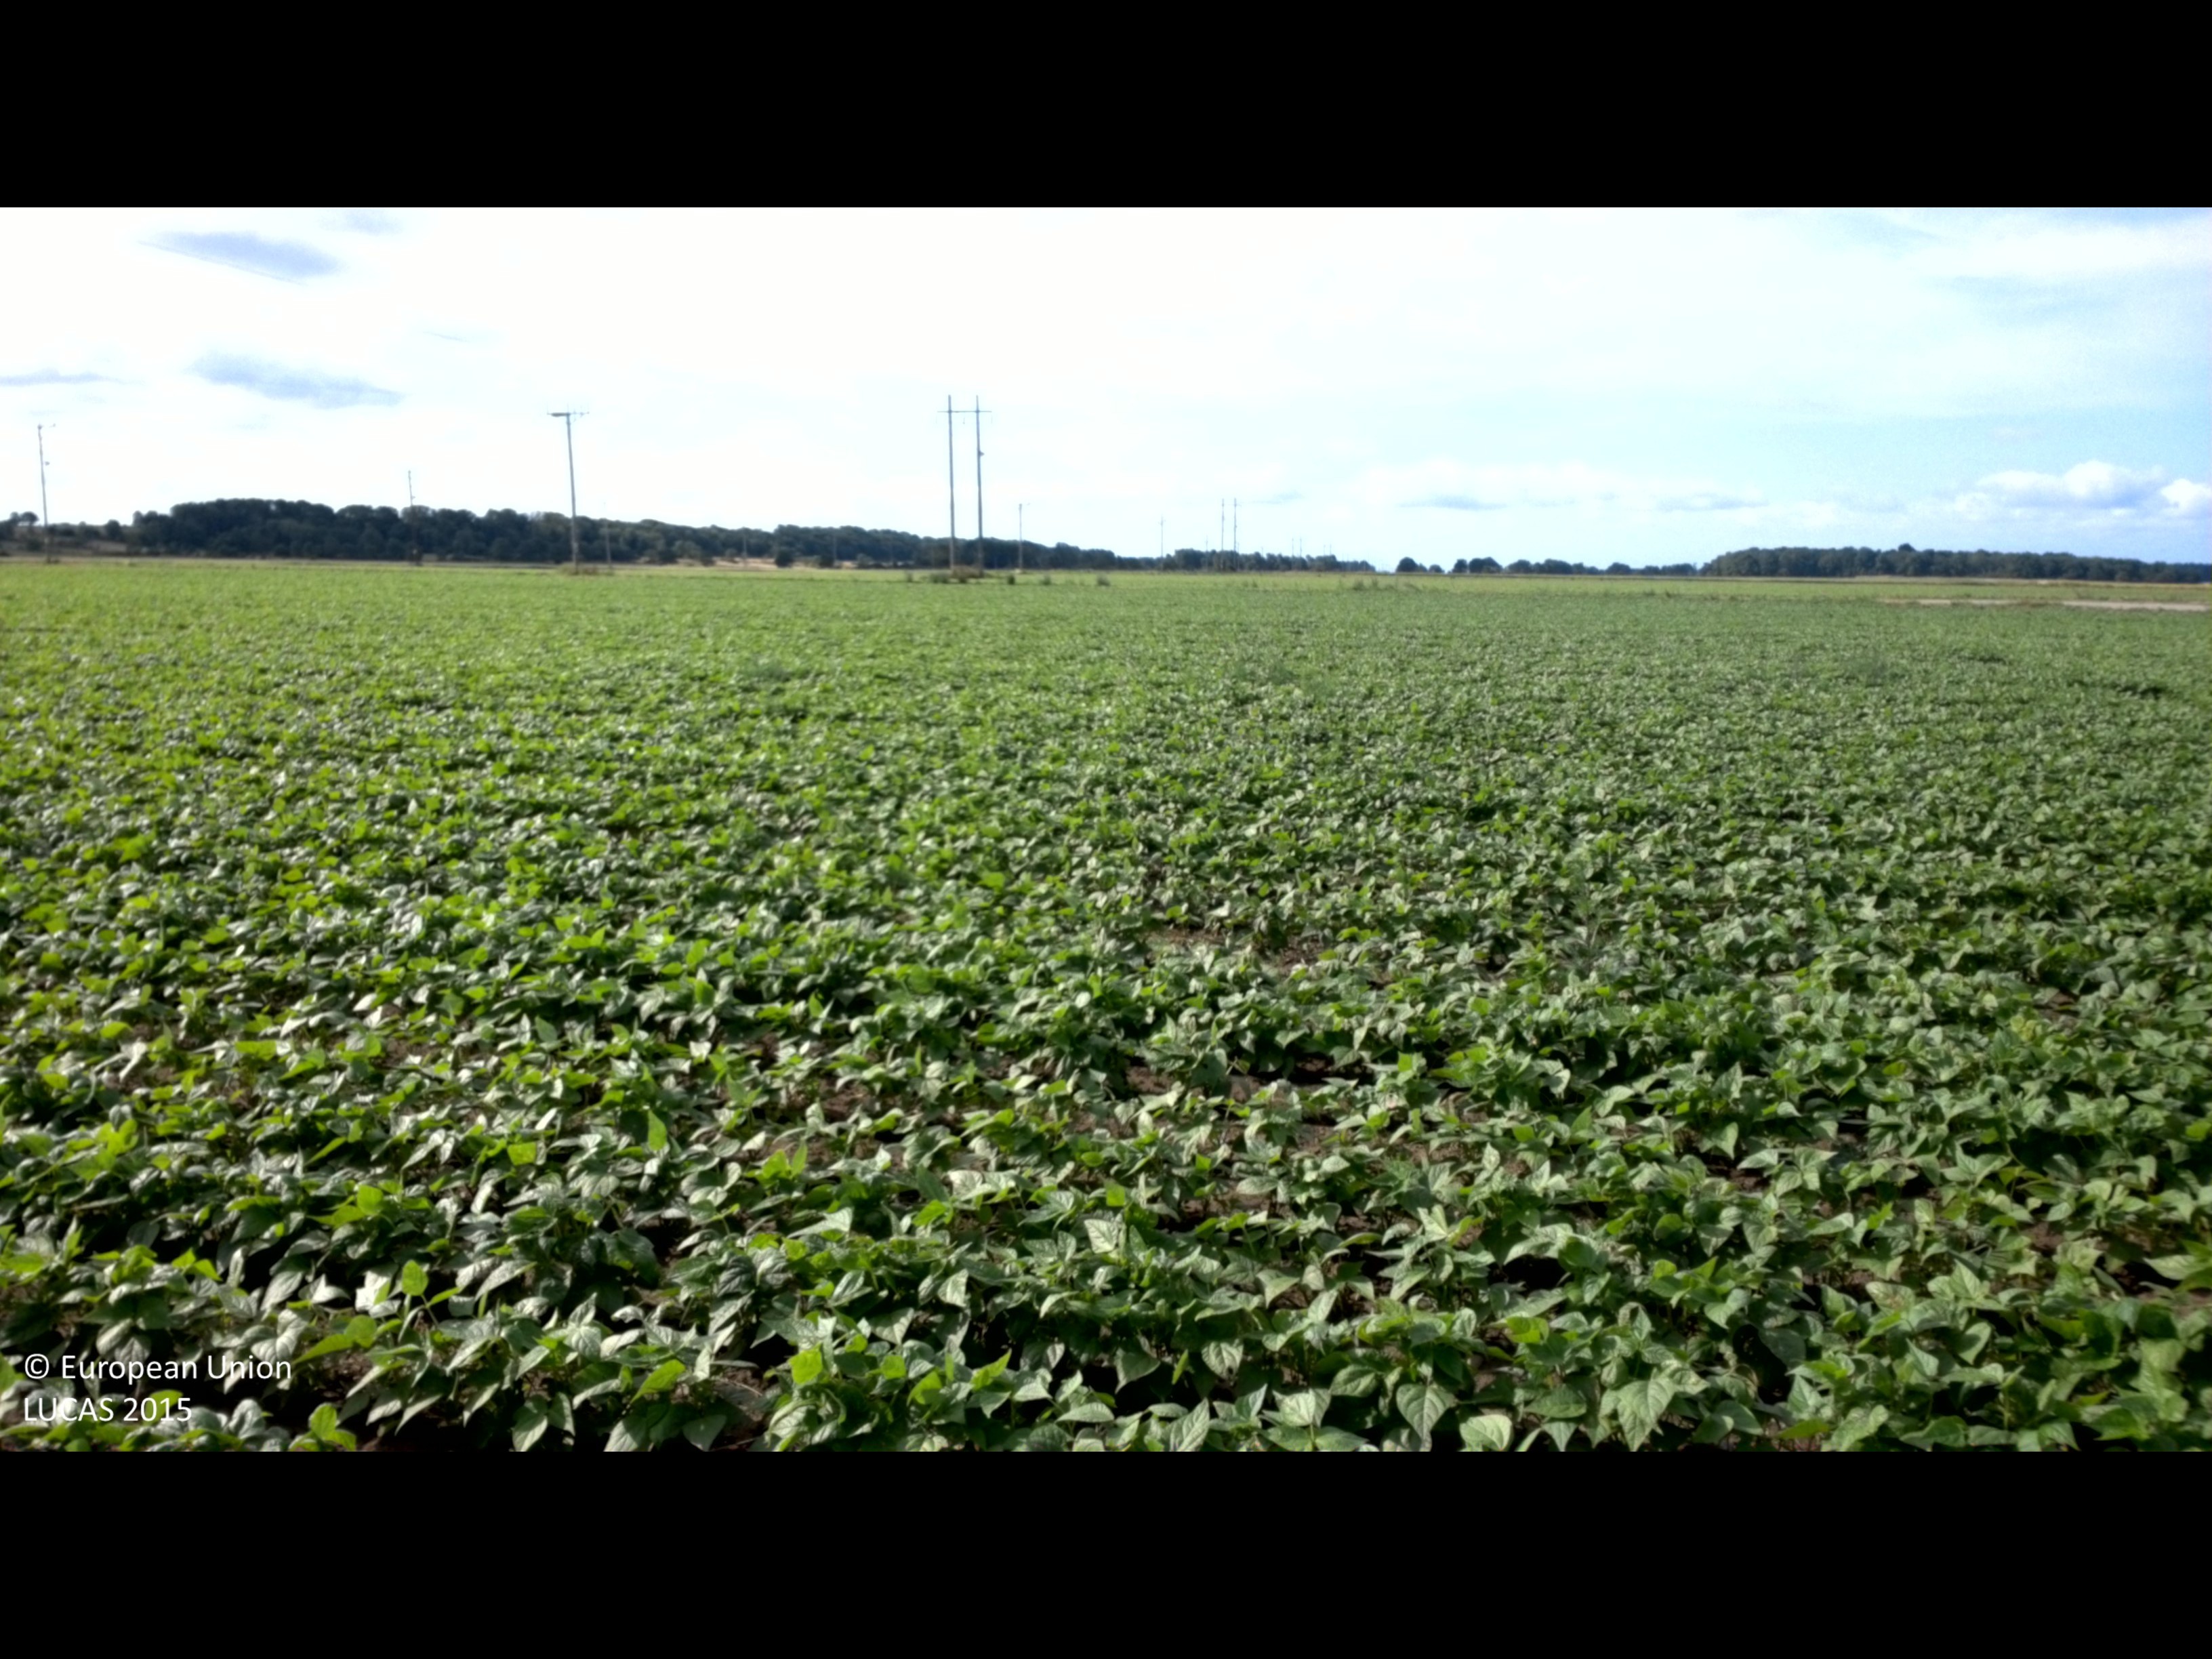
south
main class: Cropland
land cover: Dry pulses
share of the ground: > 75 %
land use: Agriculture (excluding fallow land and kitchen gardens)
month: July
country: SE
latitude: 56.5141
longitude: 16.4208
